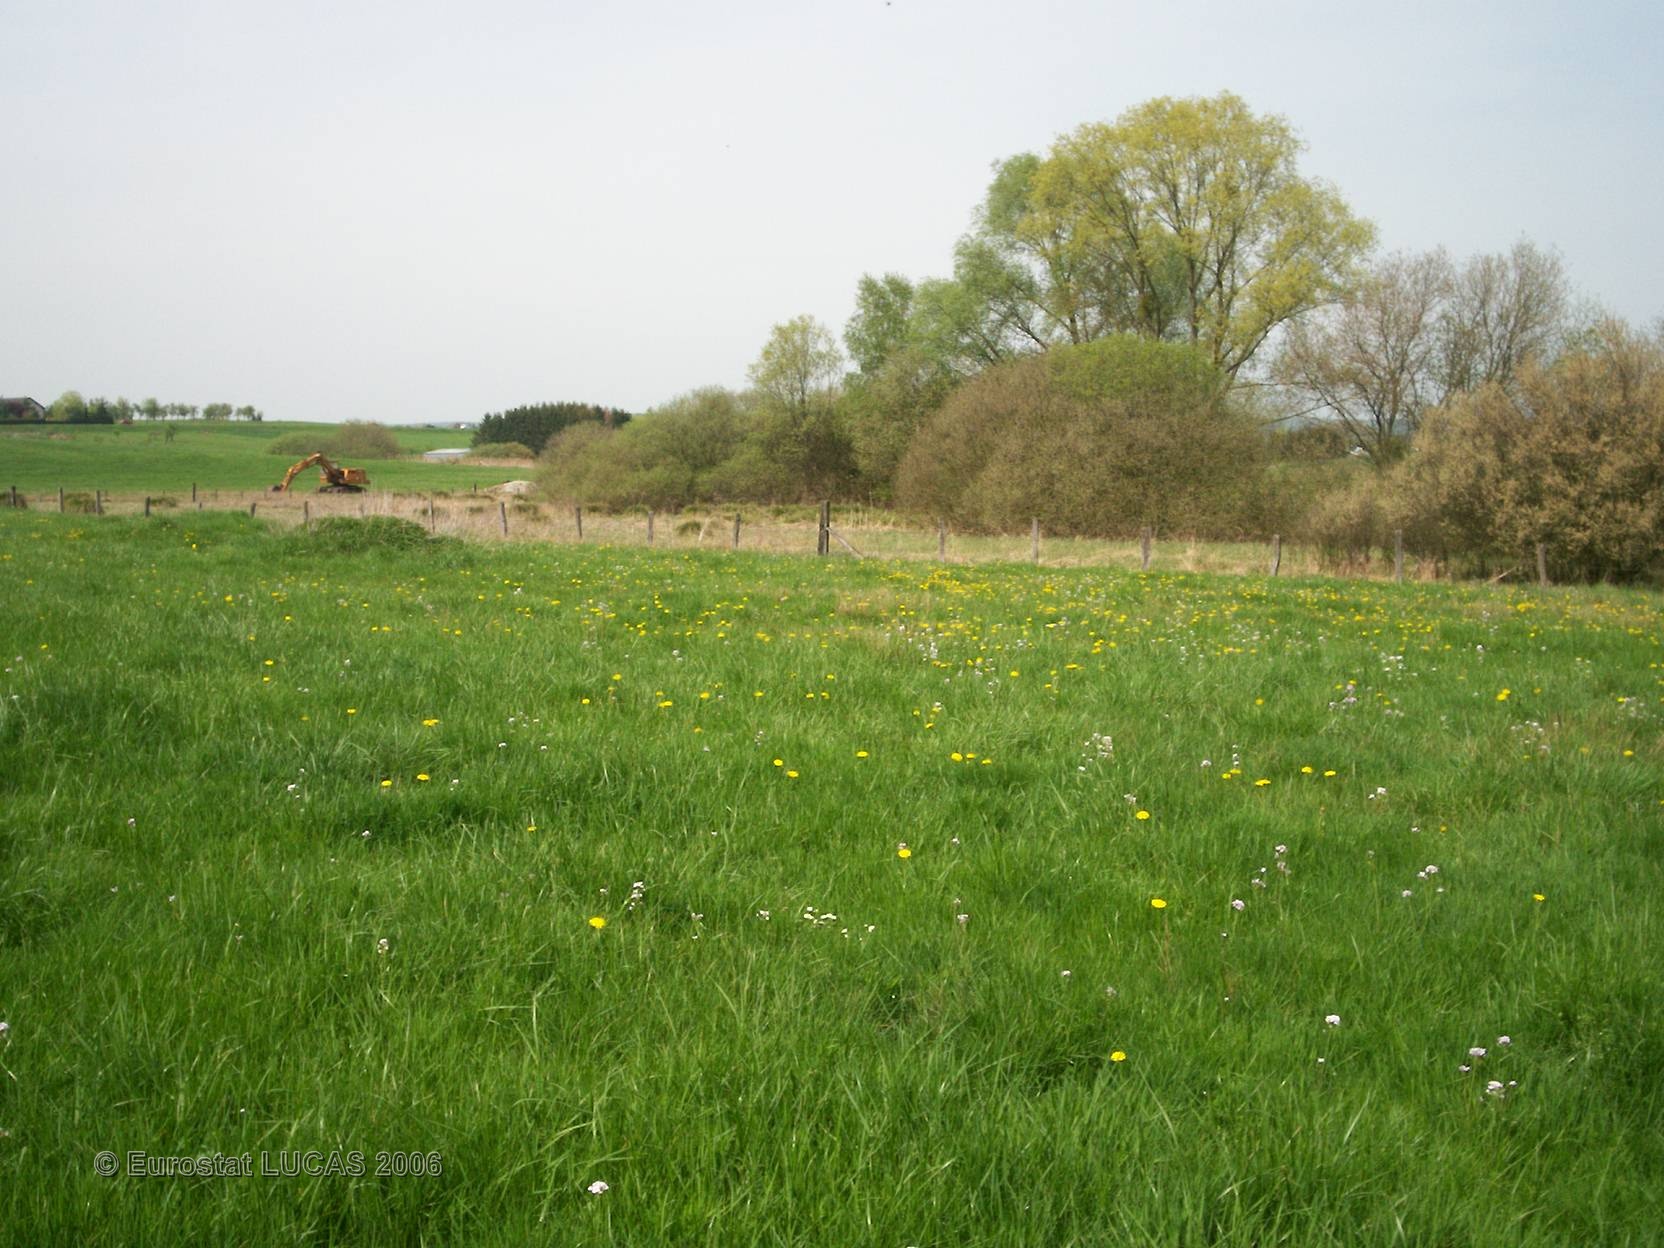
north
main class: Grassland
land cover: Grassland without tree/shrub cover
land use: Agriculture (excluding fallow land and kitchen gardens)
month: May
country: FR
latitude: 49.0650
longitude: 7.0030
